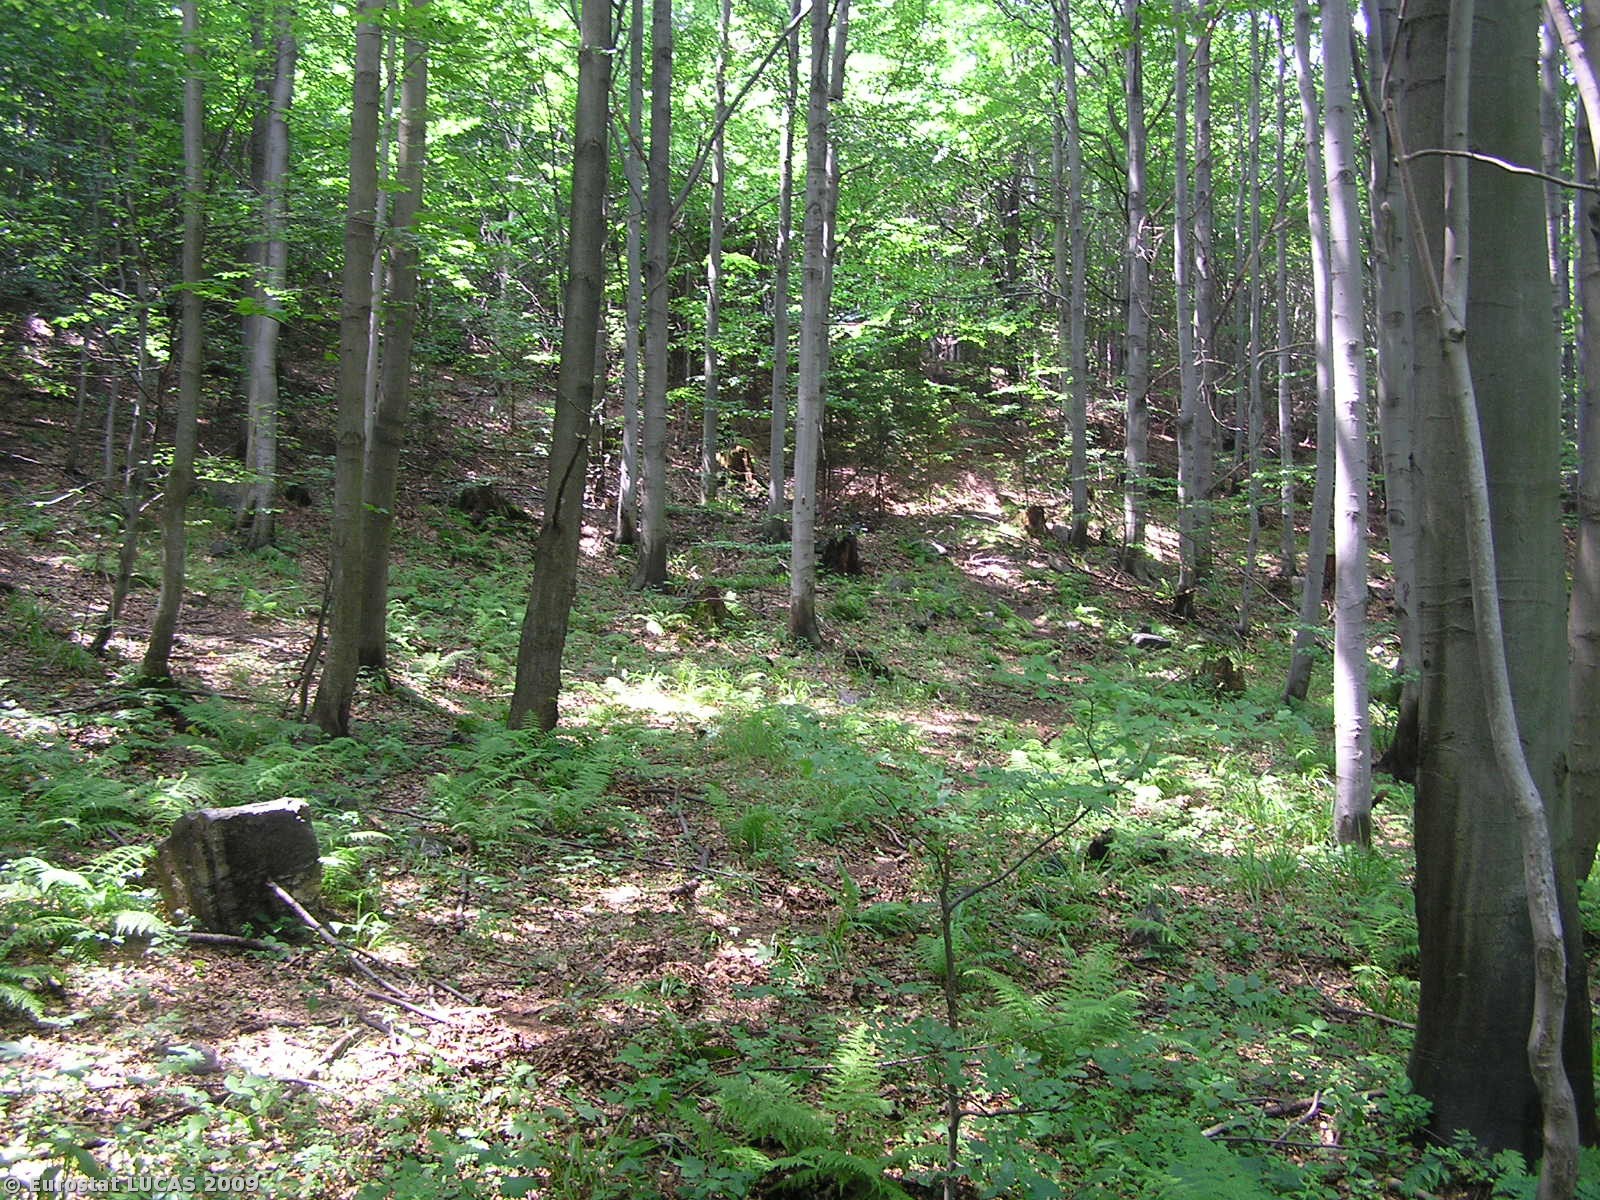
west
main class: Woodland
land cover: Broadleaved woodland
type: beech forest
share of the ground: > 75 %
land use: Forestry
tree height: > 5 m
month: July
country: CZ
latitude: 50.2415
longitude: 17.2604
